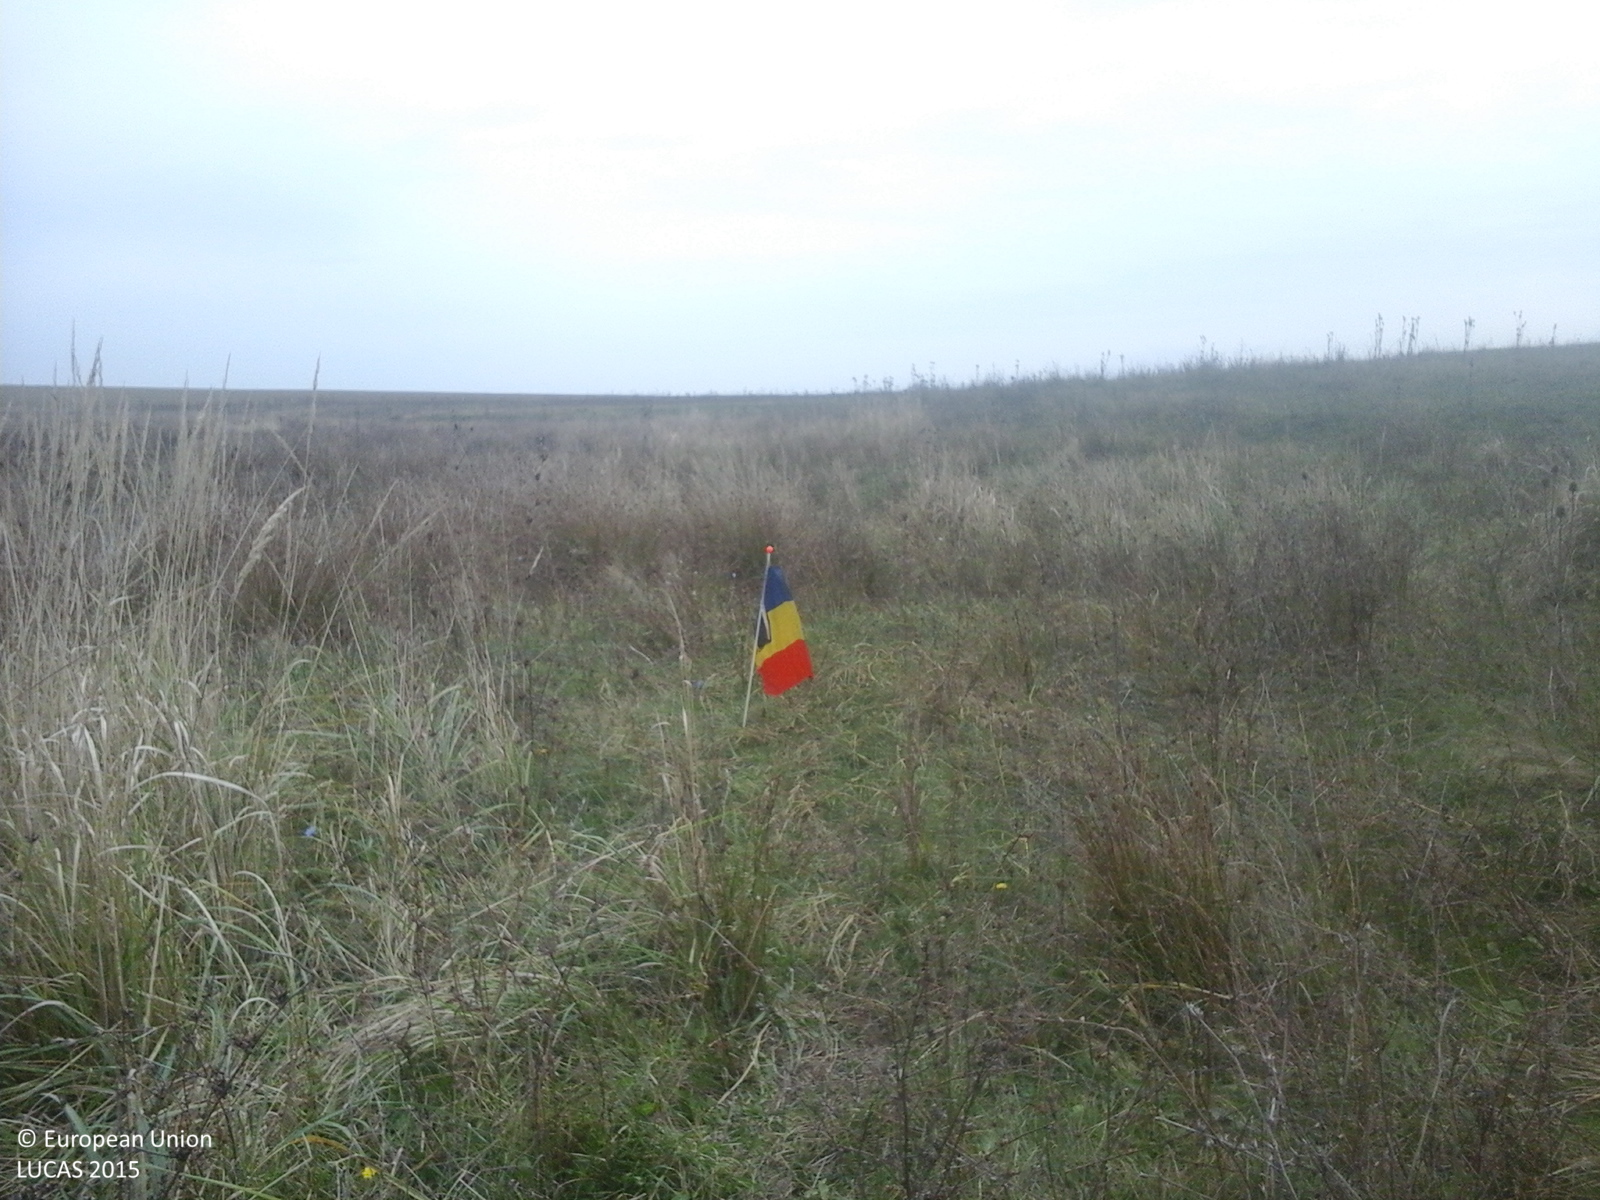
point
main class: Grassland
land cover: Spontaneously vegetated surfaces
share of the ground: > 75 %
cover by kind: herbaceous plants 100 %
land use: Agriculture (excluding fallow land and kitchen gardens)
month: October
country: RO
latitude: 44.9578
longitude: 25.7316
